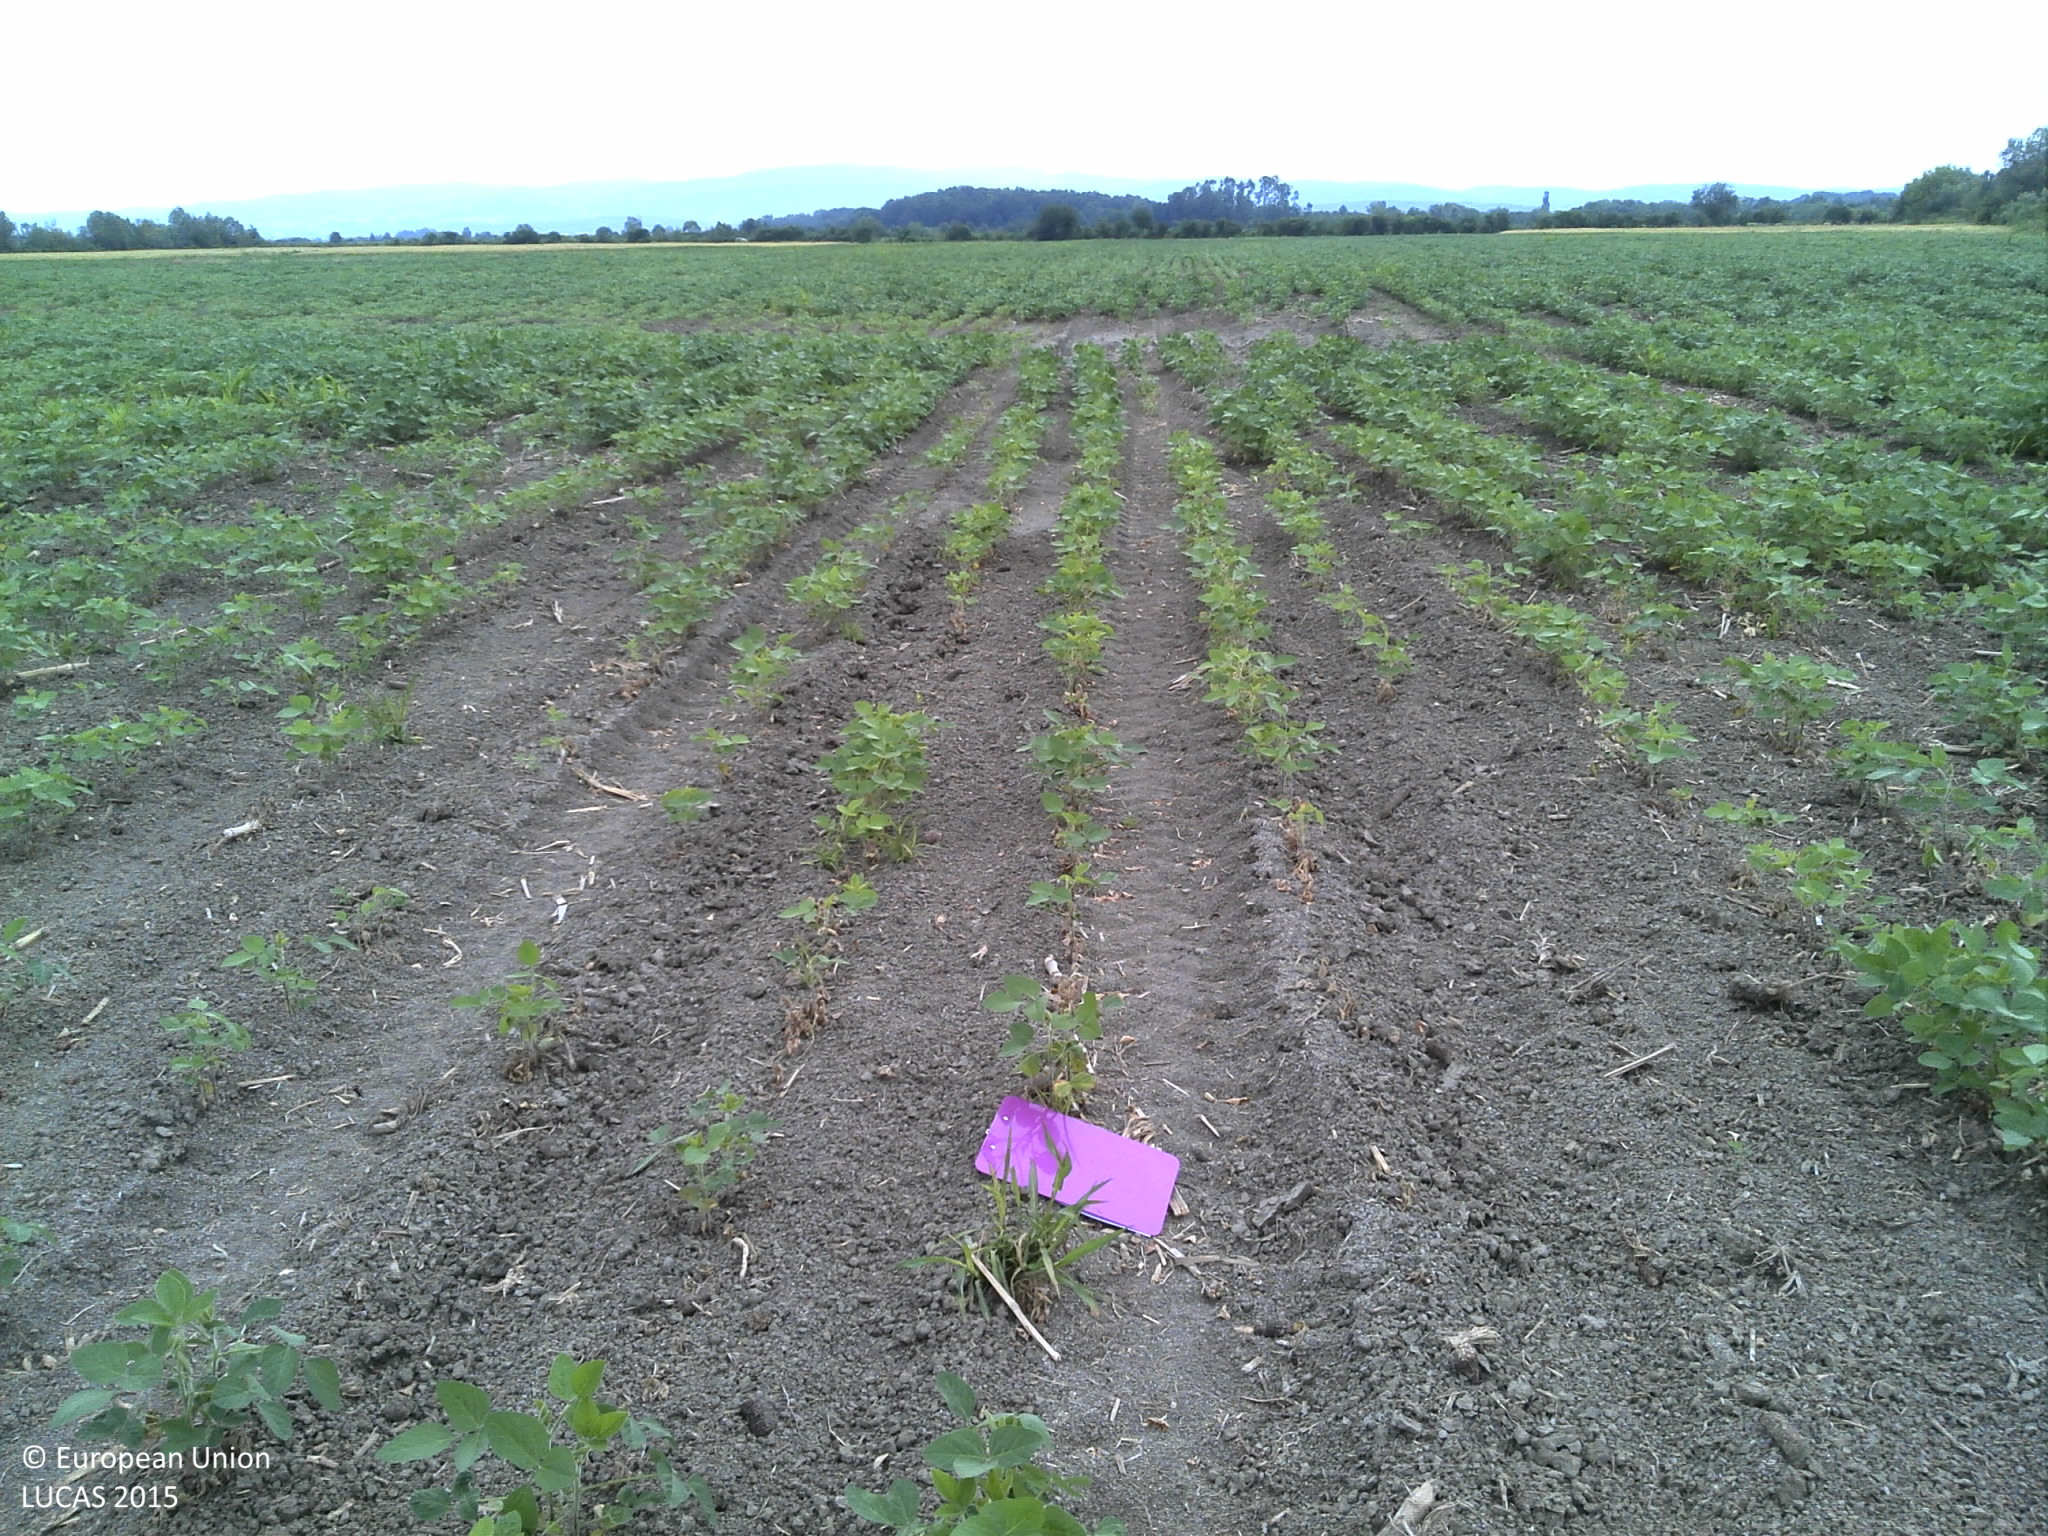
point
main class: Cropland
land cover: Soya
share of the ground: 25 - 50 %
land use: Agriculture (excluding fallow land and kitchen gardens)
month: June
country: HR
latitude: 45.1582
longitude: 17.5950
